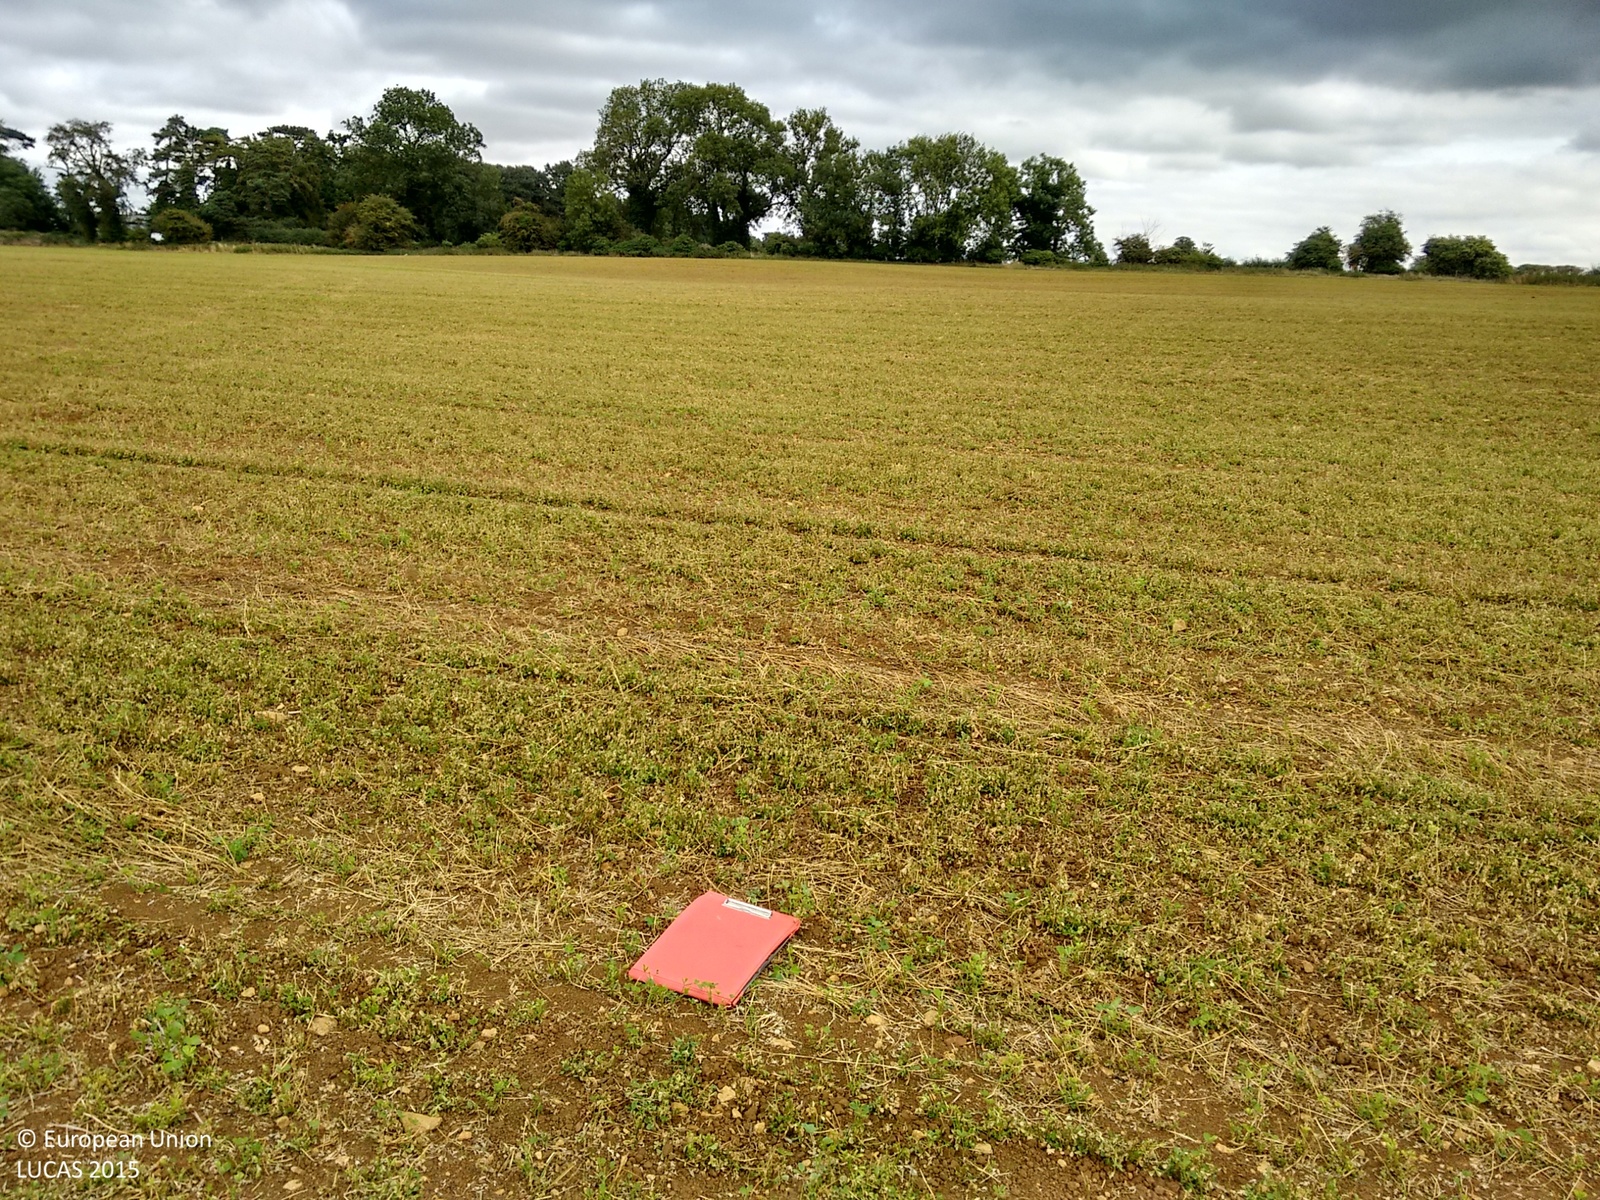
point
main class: Cropland
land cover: Dry pulses
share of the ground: 10 - 25 %
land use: Agriculture (excluding fallow land and kitchen gardens)
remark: Harvested field
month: August
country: GB
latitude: 52.2933
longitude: -0.8780
